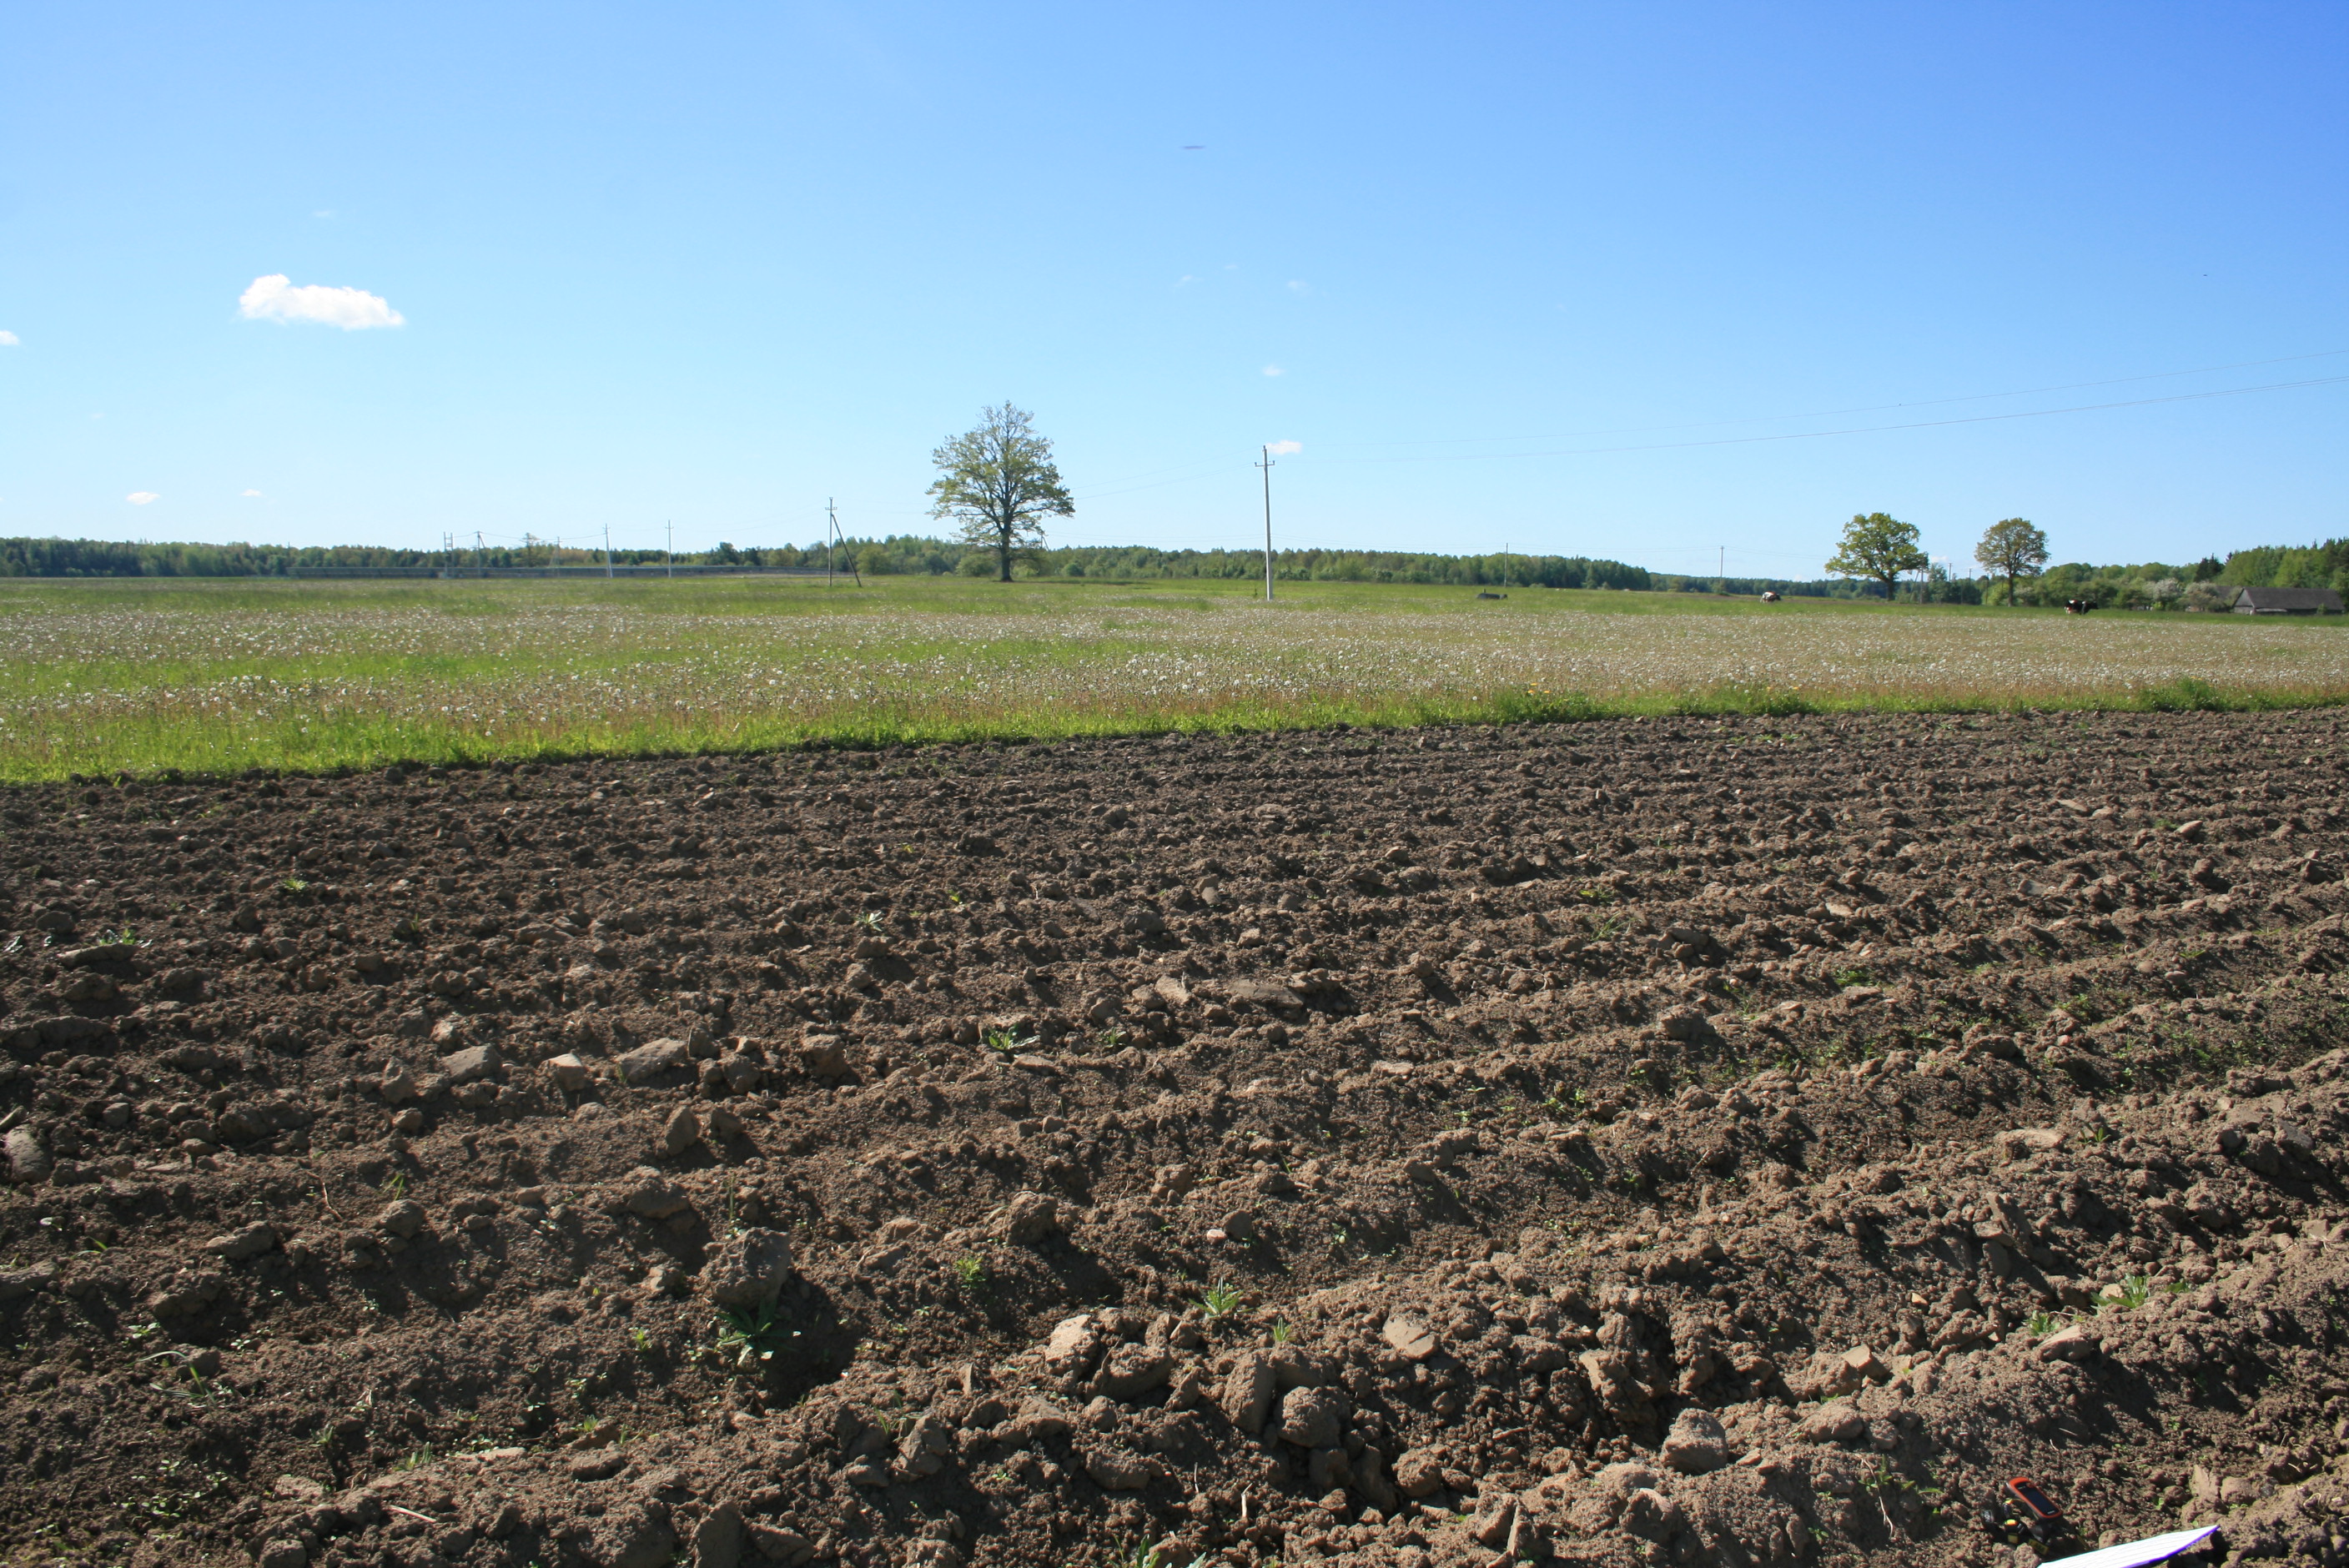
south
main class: Cropland
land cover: Potatoes
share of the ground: < 10 %
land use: Agriculture (excluding fallow land and kitchen gardens)
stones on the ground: < 10 %
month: May
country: LT
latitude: 56.2131
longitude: 22.2929
